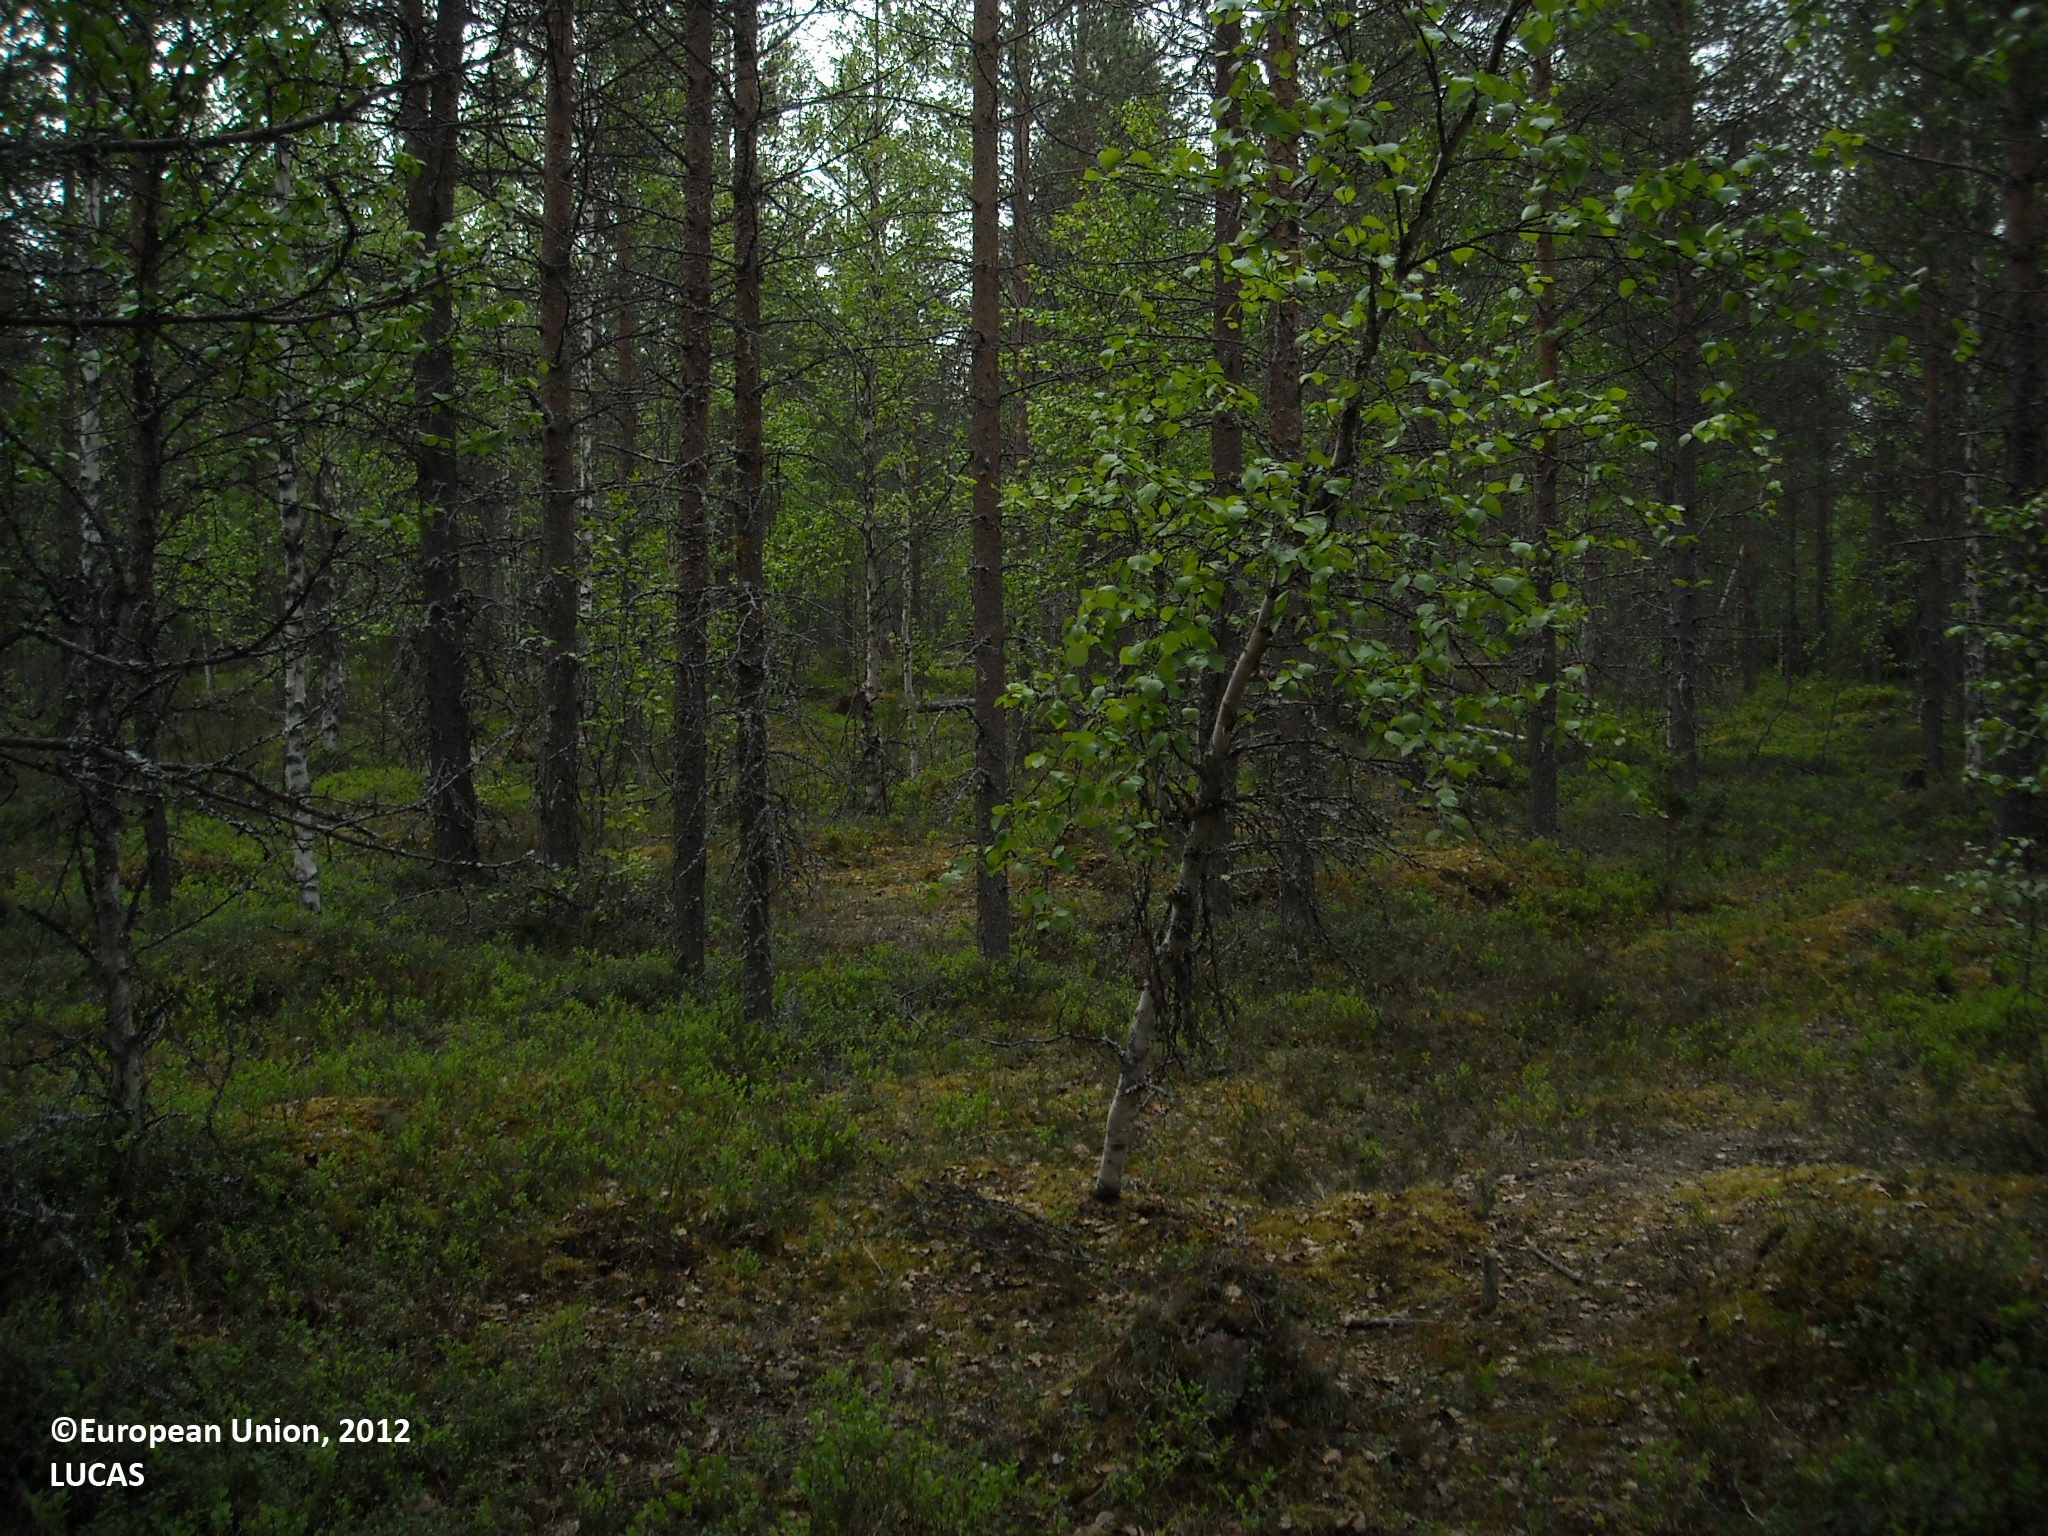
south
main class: Woodland
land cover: Pine dominated mixed woodland
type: boreal forest
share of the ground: > 75 %
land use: Forestry
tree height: > 5 m
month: June
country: FI
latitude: 65.5723
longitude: 28.0233
